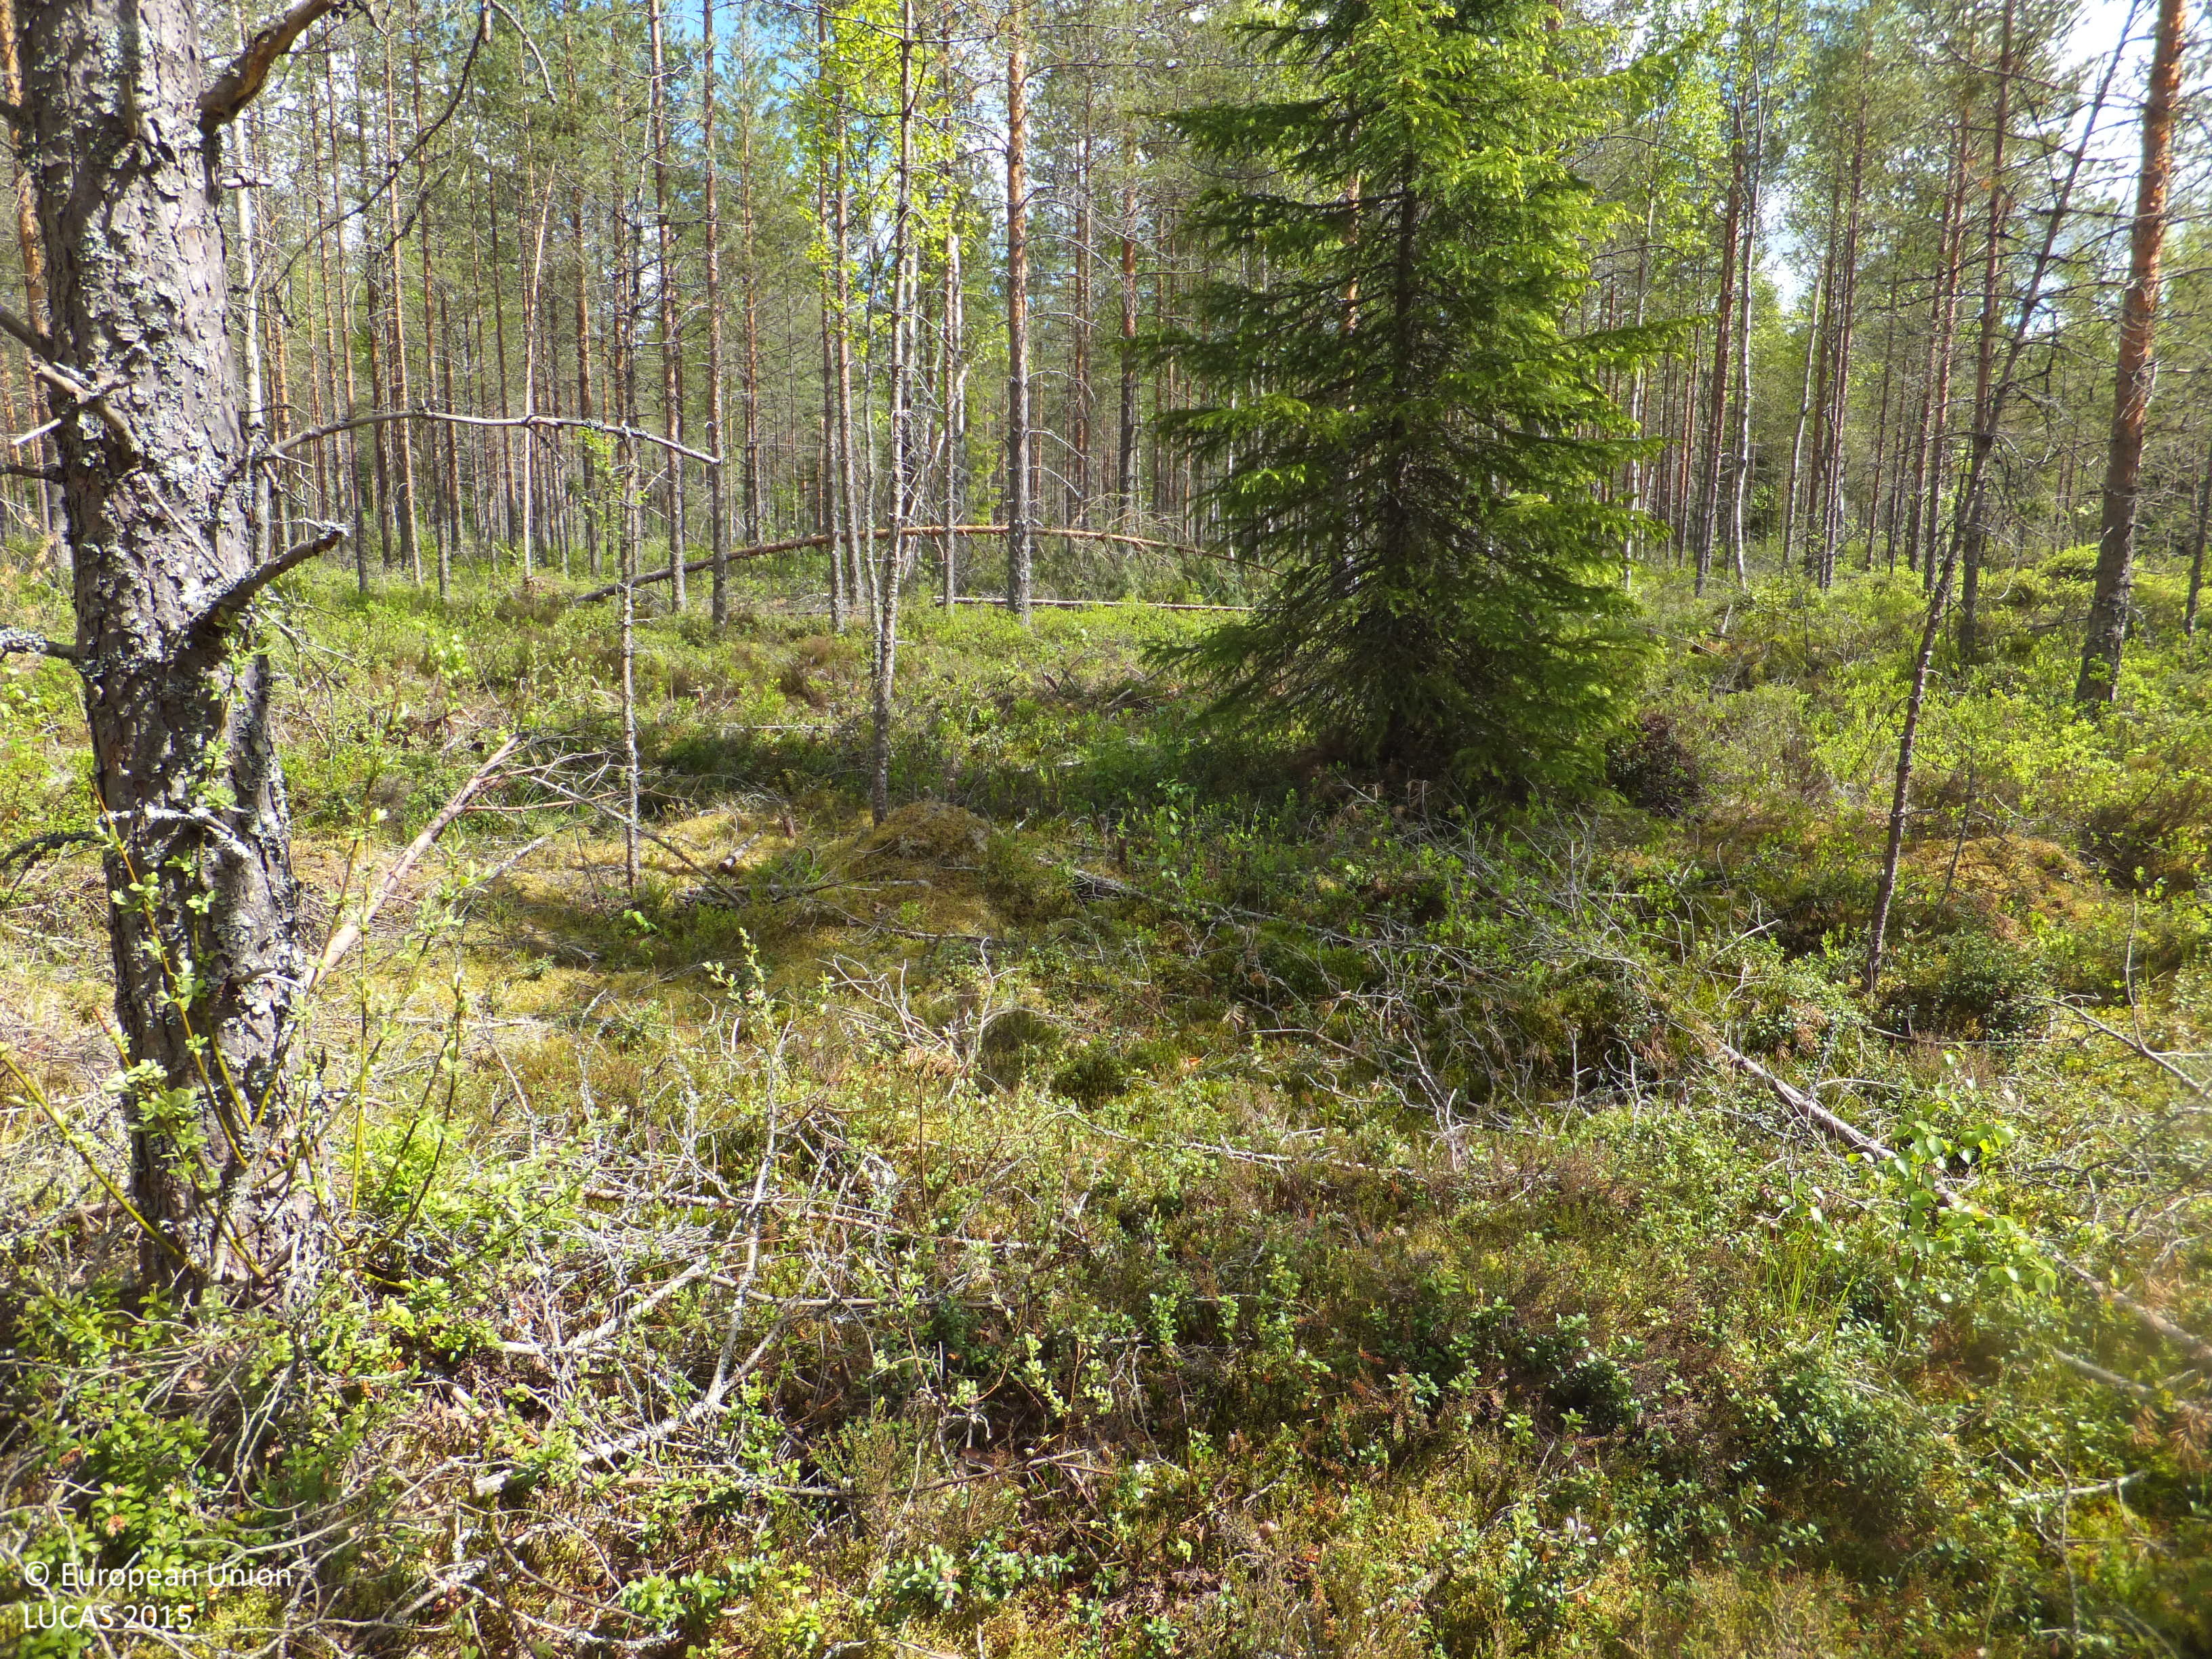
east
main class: Woodland
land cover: Pine dominated coniferous woodland
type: boreal forest
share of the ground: > 75 %
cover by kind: coniferous forest trees 95 %, shrubs 5 %
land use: Forestry
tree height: > 5 m
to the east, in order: Pine dominated coniferous woodland; Other mixed woodland; Tracks; Pine dominated mixed woodland; Tracks; Pine dominated mixed woodland; Ditches and canals; Pine dominated mixed woodland; Tracks; Pine dominated mixed woodland; Ditches and canals; Pine dominated mixed woodland; Ditches and canals; Pine dominated mixed woodland
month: June
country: FI
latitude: 63.4225
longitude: 22.9762
